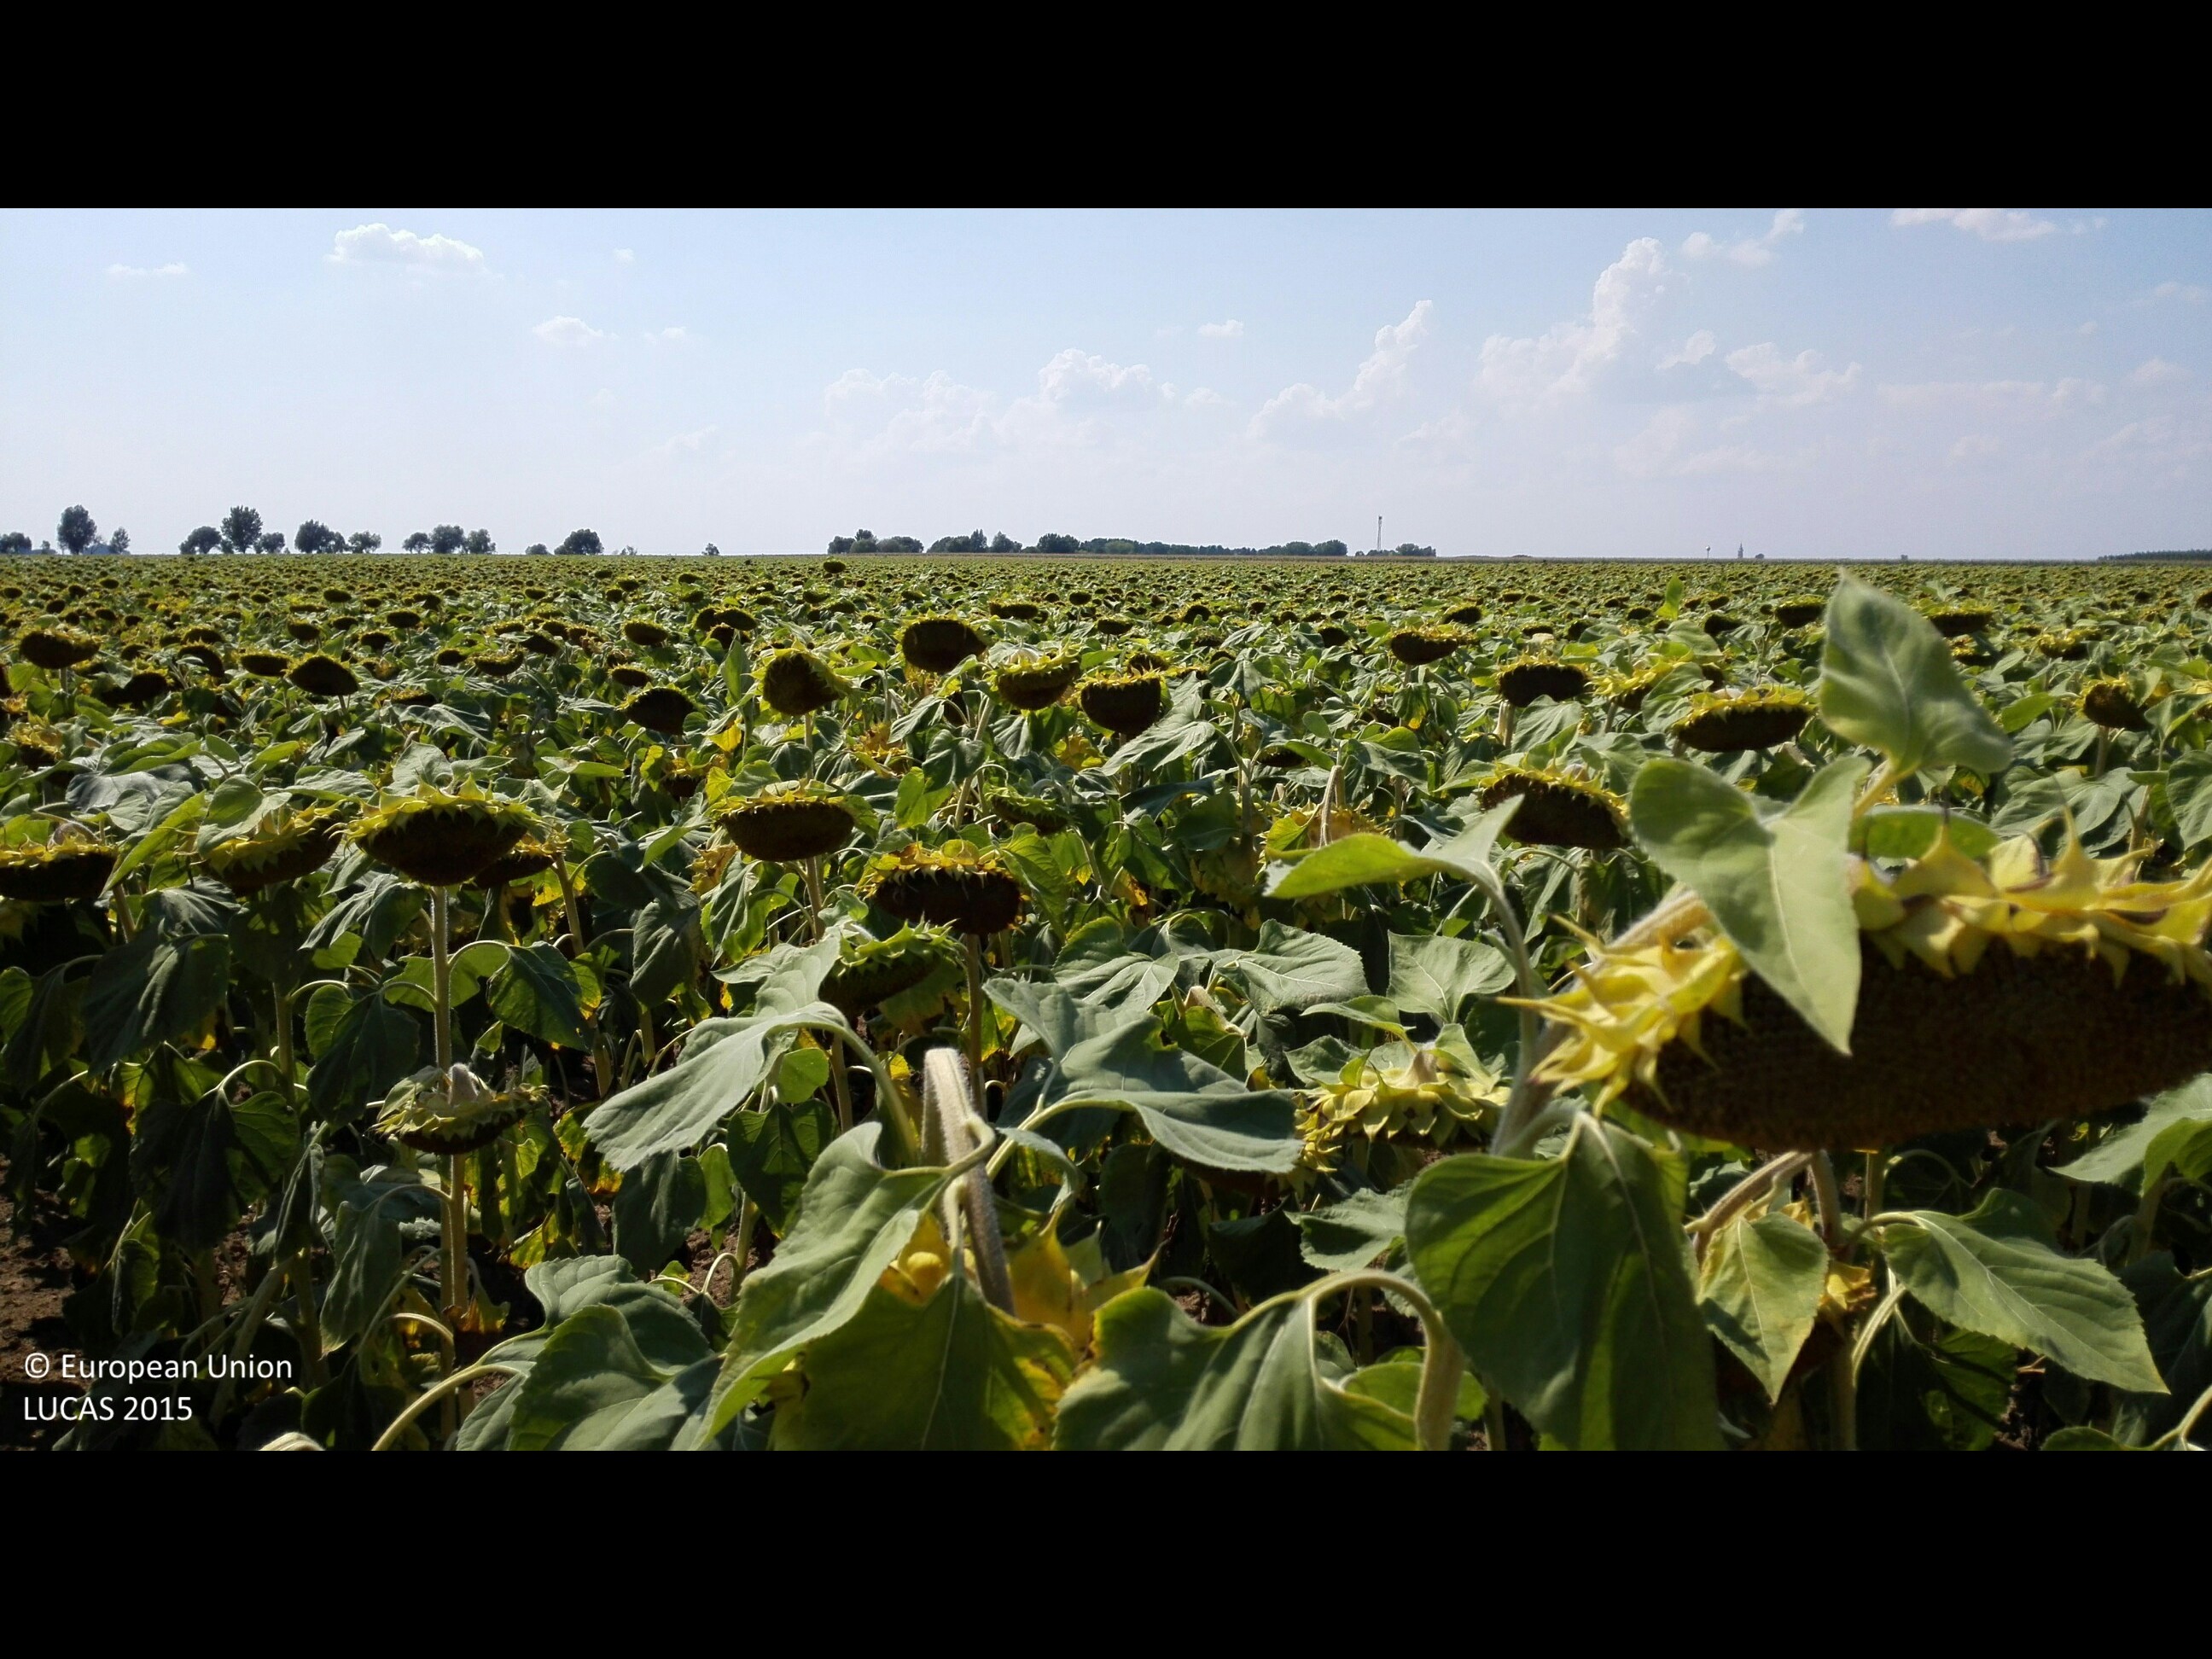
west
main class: Cropland
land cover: Sunflower
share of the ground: > 75 %
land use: Agriculture (excluding fallow land and kitchen gardens)
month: August
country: HU
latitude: 47.4355
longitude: 22.0225
